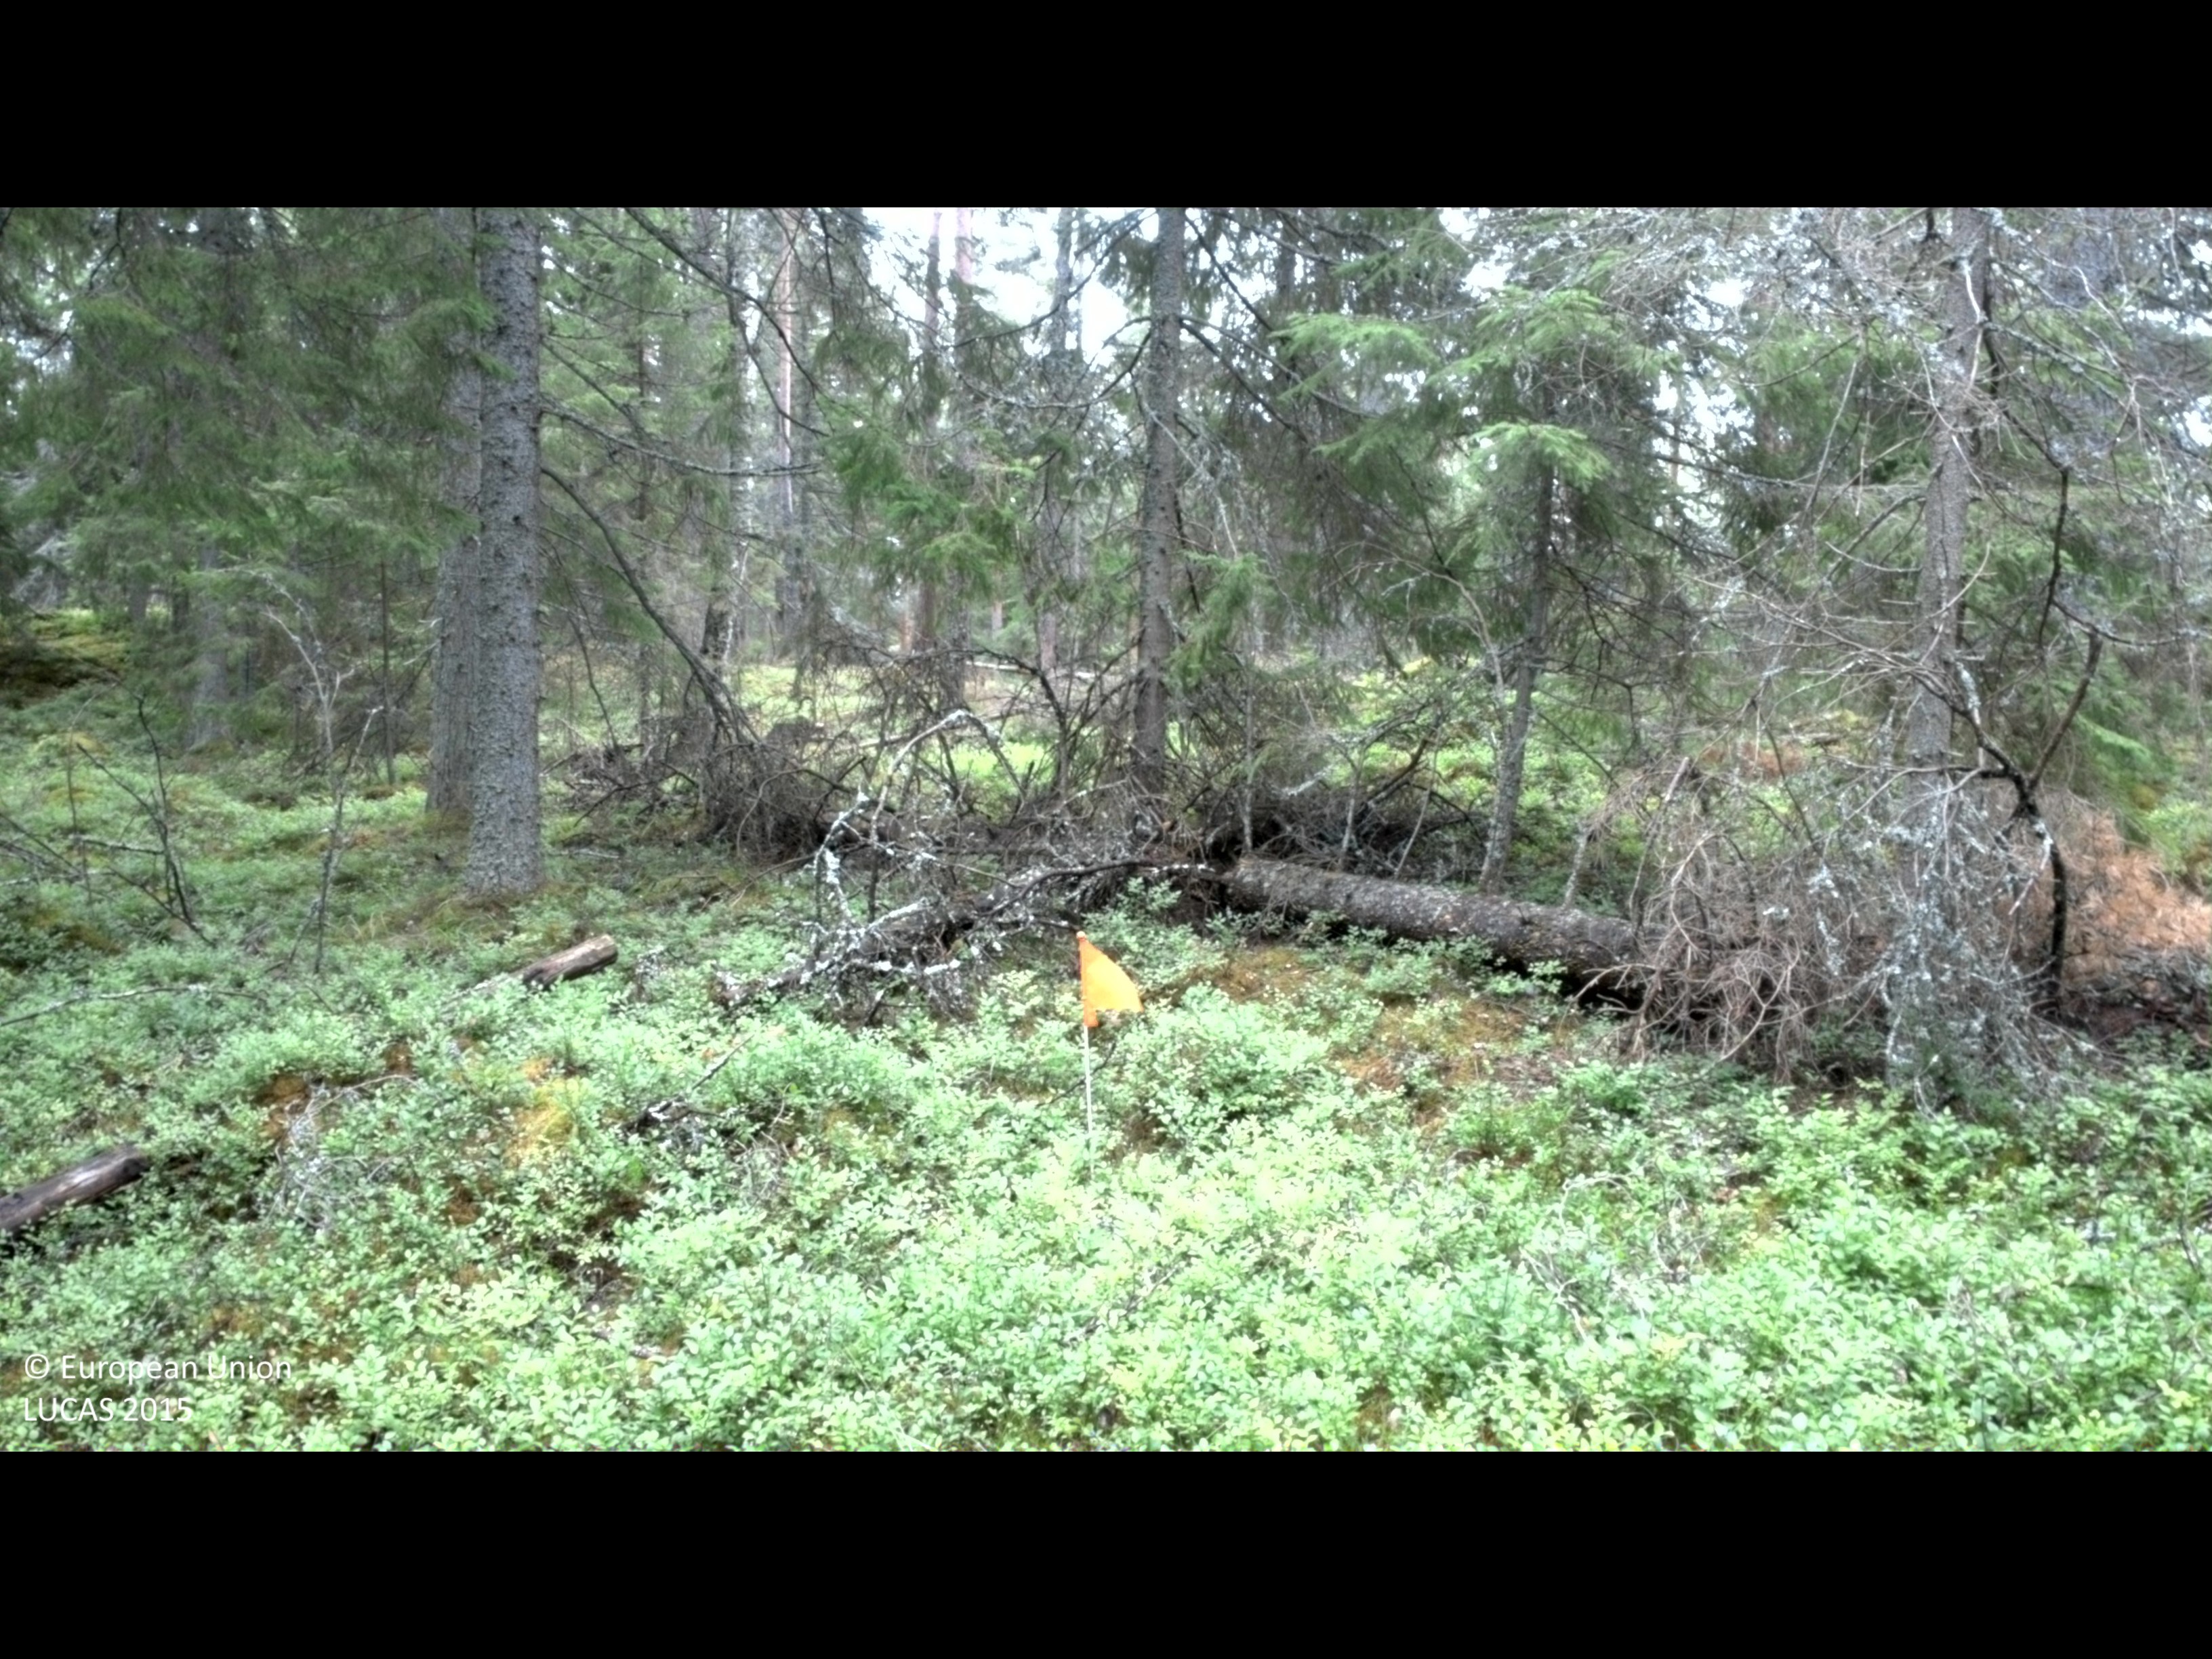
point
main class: Woodland
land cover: Other coniferous woodland
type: boreal forest
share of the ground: 50 - 75 %
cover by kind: coniferous forest trees 55 %, shrubs 35 %, broadleaved forest trees 10 %
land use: Amenities, museums, leisure
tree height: > 5 m
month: July
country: SE
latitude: 58.3115
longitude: 16.1915
